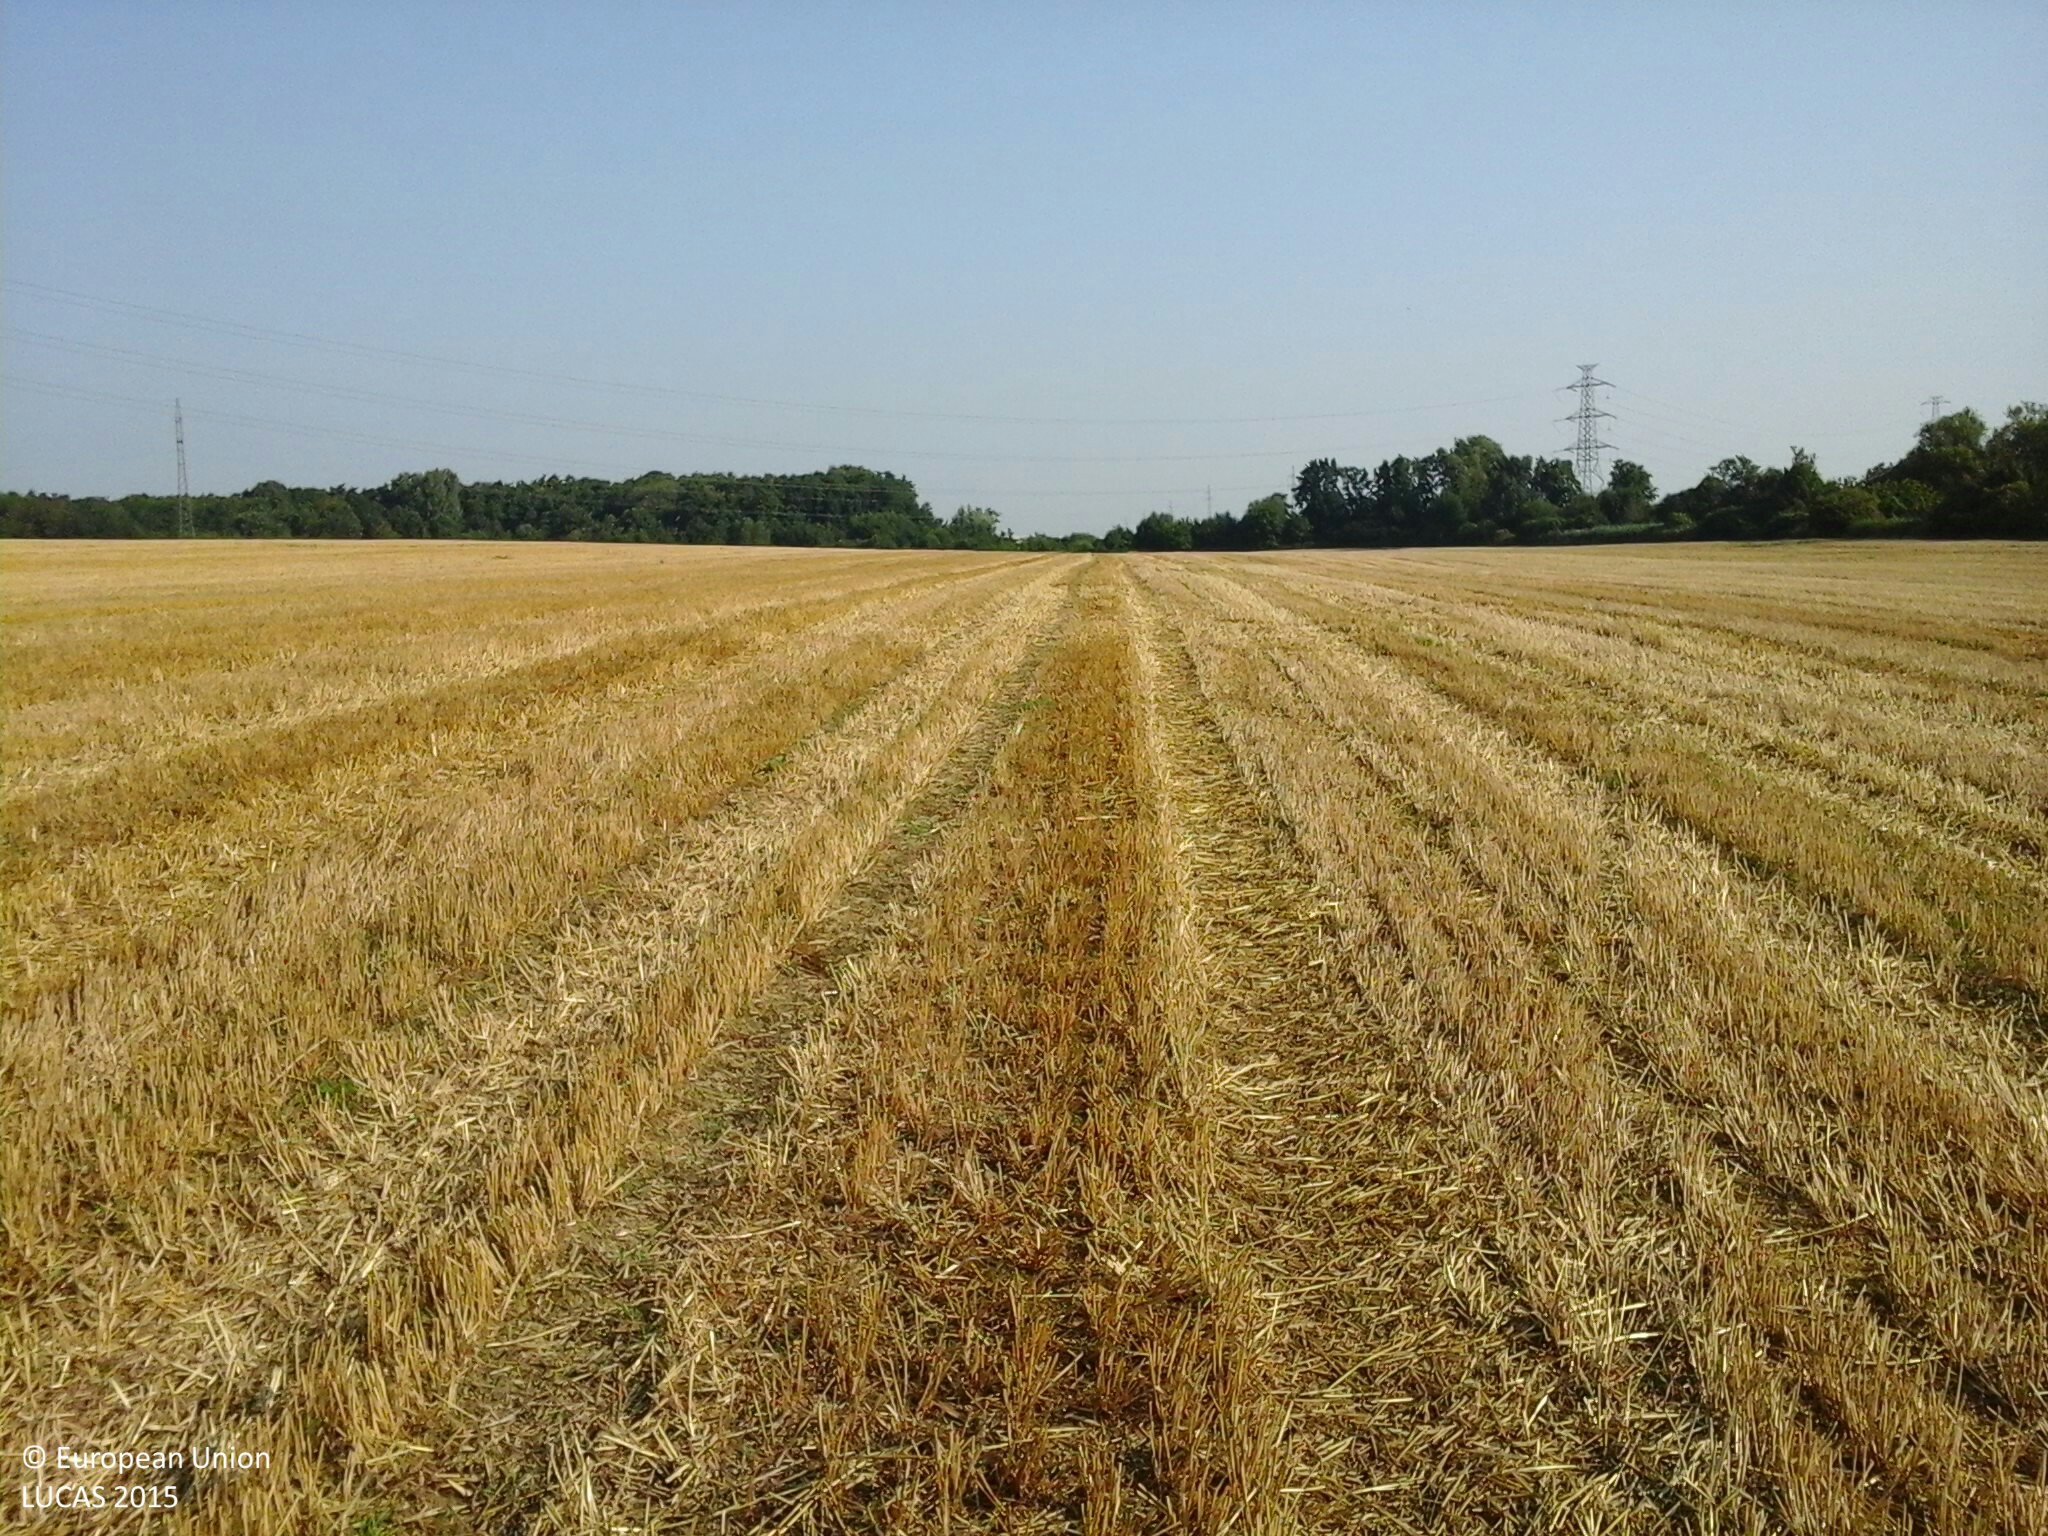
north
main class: Cropland
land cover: Common wheat
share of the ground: 25 - 50 %
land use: Agriculture (excluding fallow land and kitchen gardens)
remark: Harvested field
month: August
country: HU
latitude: 47.2430
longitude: 16.7019
